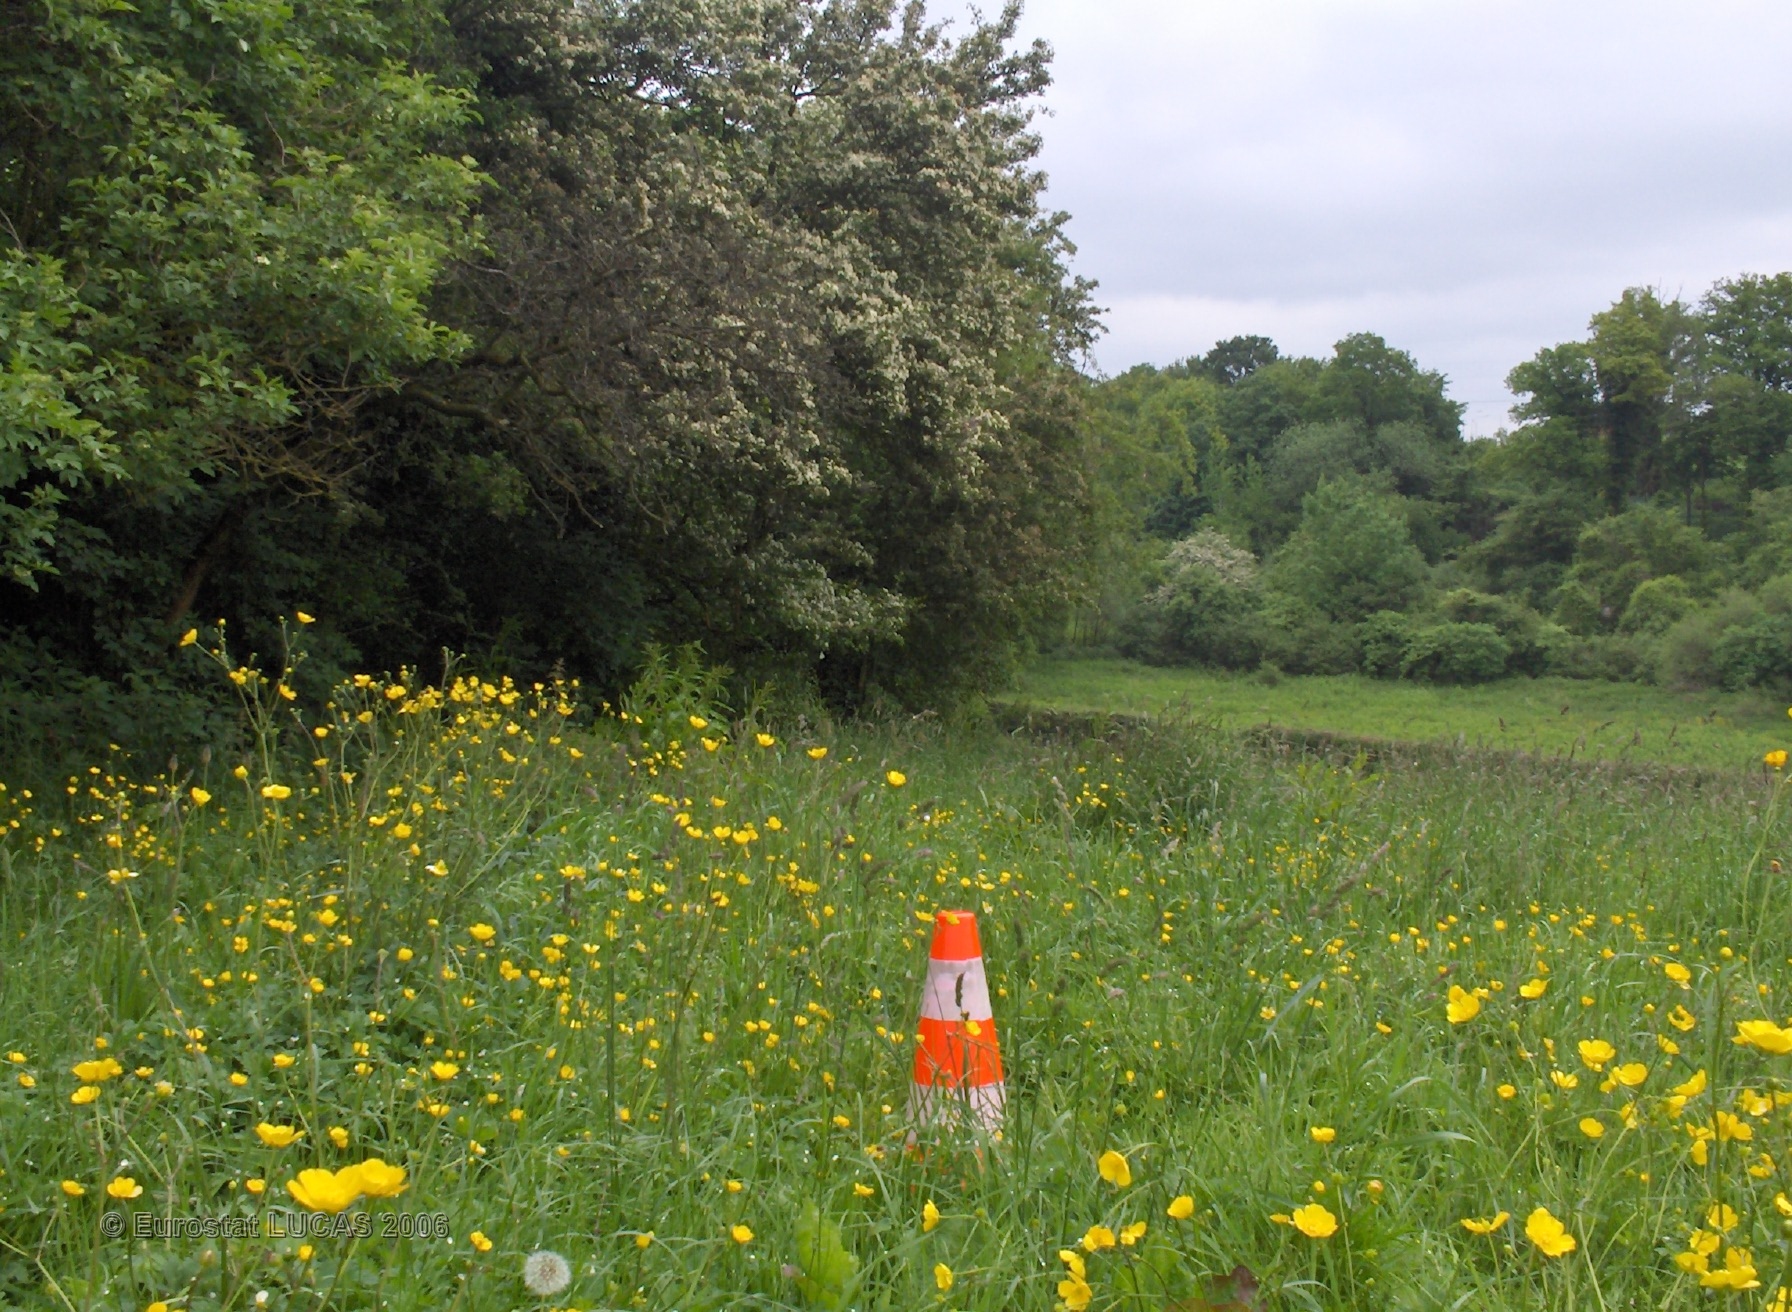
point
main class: Grassland
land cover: Grassland without tree/shrub cover
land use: Agriculture (excluding fallow land and kitchen gardens)
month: June
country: BE
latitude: 50.1787
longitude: 4.5207
